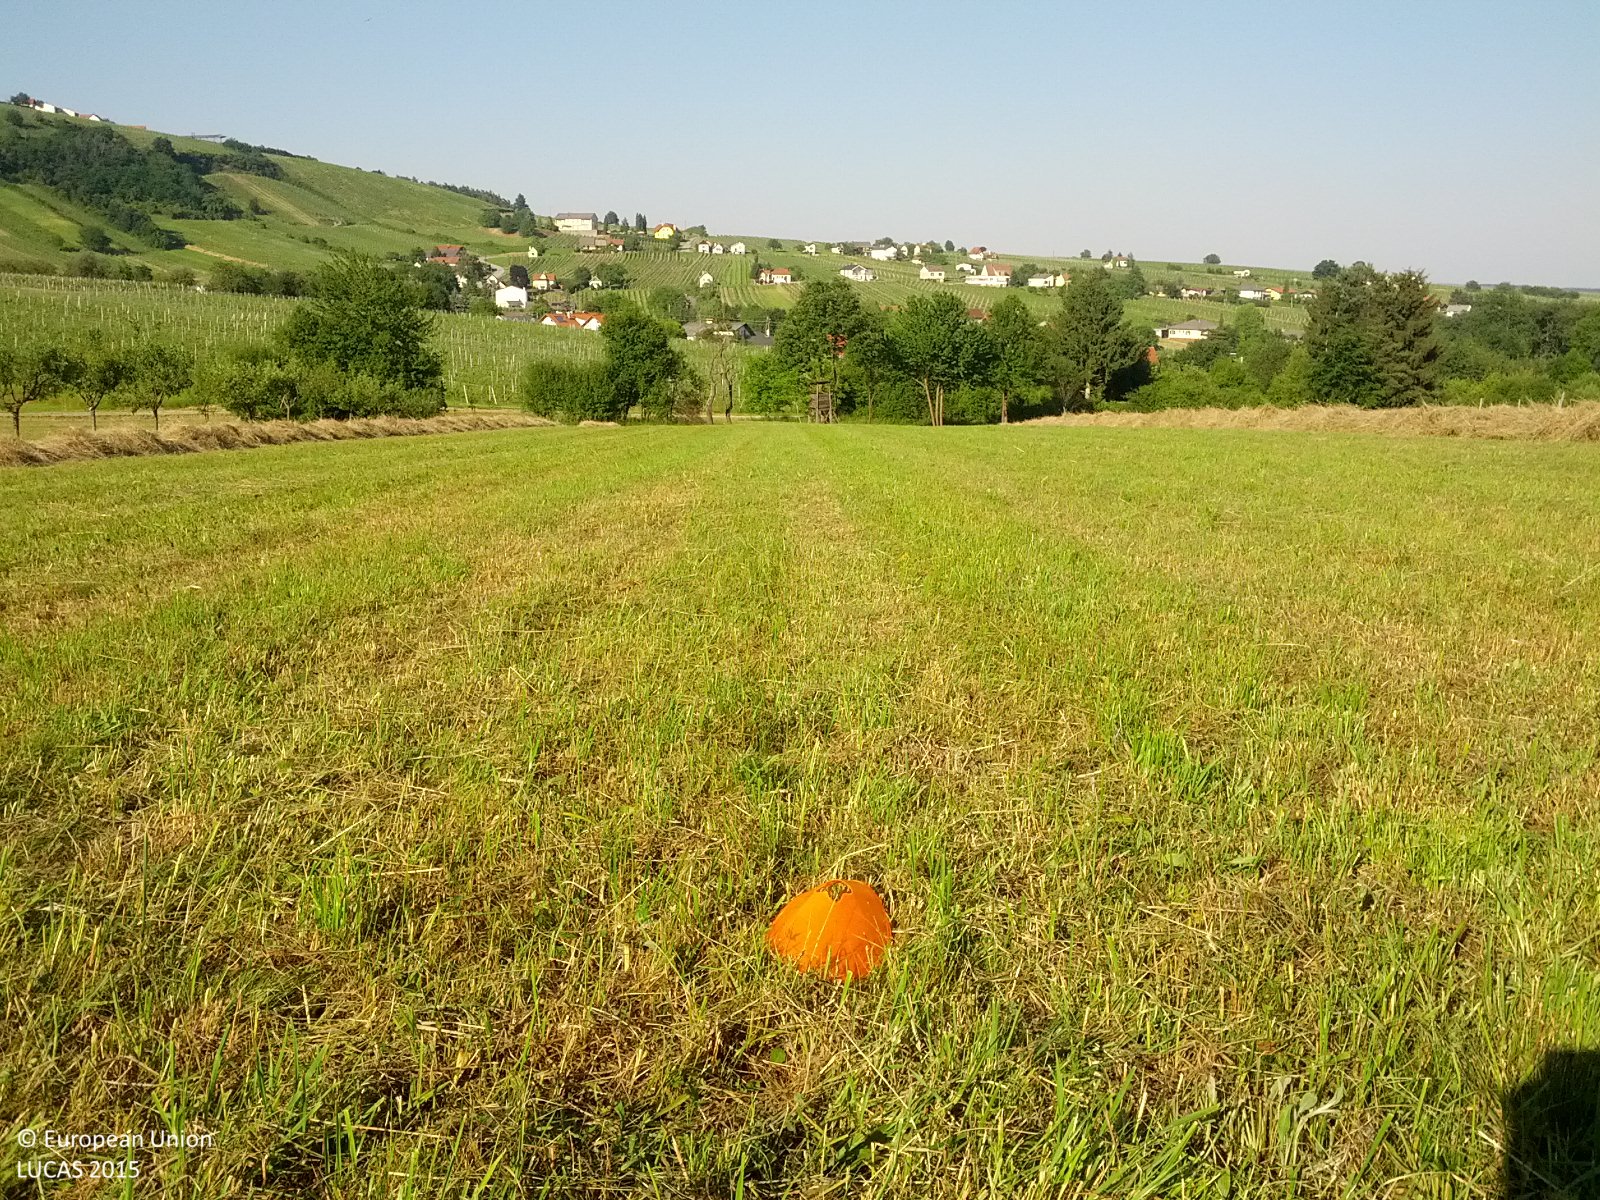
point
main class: Grassland
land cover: Grassland without tree/shrub cover
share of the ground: > 75 %
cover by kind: herbaceous plants 100 %
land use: Agriculture (excluding fallow land and kitchen gardens)
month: June
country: AT
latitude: 47.1888
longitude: 16.4035
